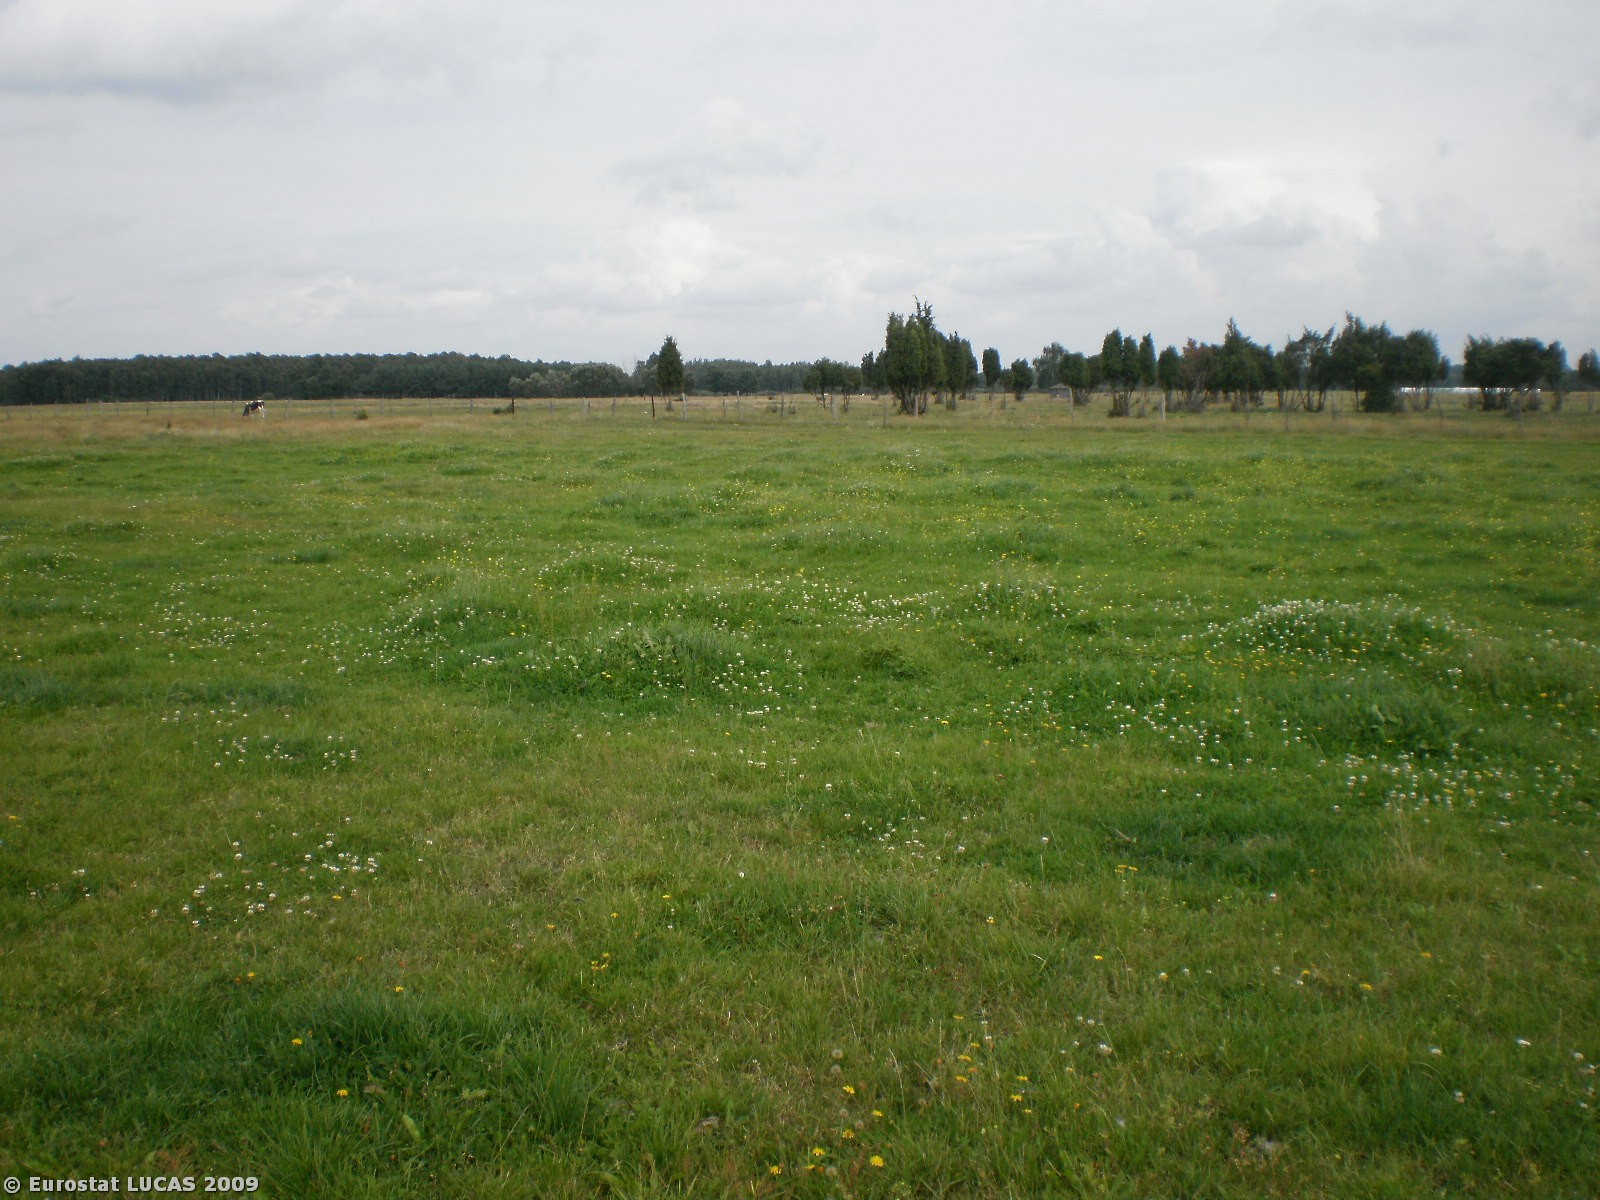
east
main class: Grassland
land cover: Grassland without tree/shrub cover
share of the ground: > 75 %
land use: Agriculture (excluding fallow land and kitchen gardens)
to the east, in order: Grassland without tree/shrub cover; Tracks; Fences; Grassland without tree/shrub cover; Grassland with sparse tree/shrub cover; Grassland without tree/shrub cover; Fences; Grassland without tree/shrub cover
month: August
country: PL
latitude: 53.2469
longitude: 20.9682
